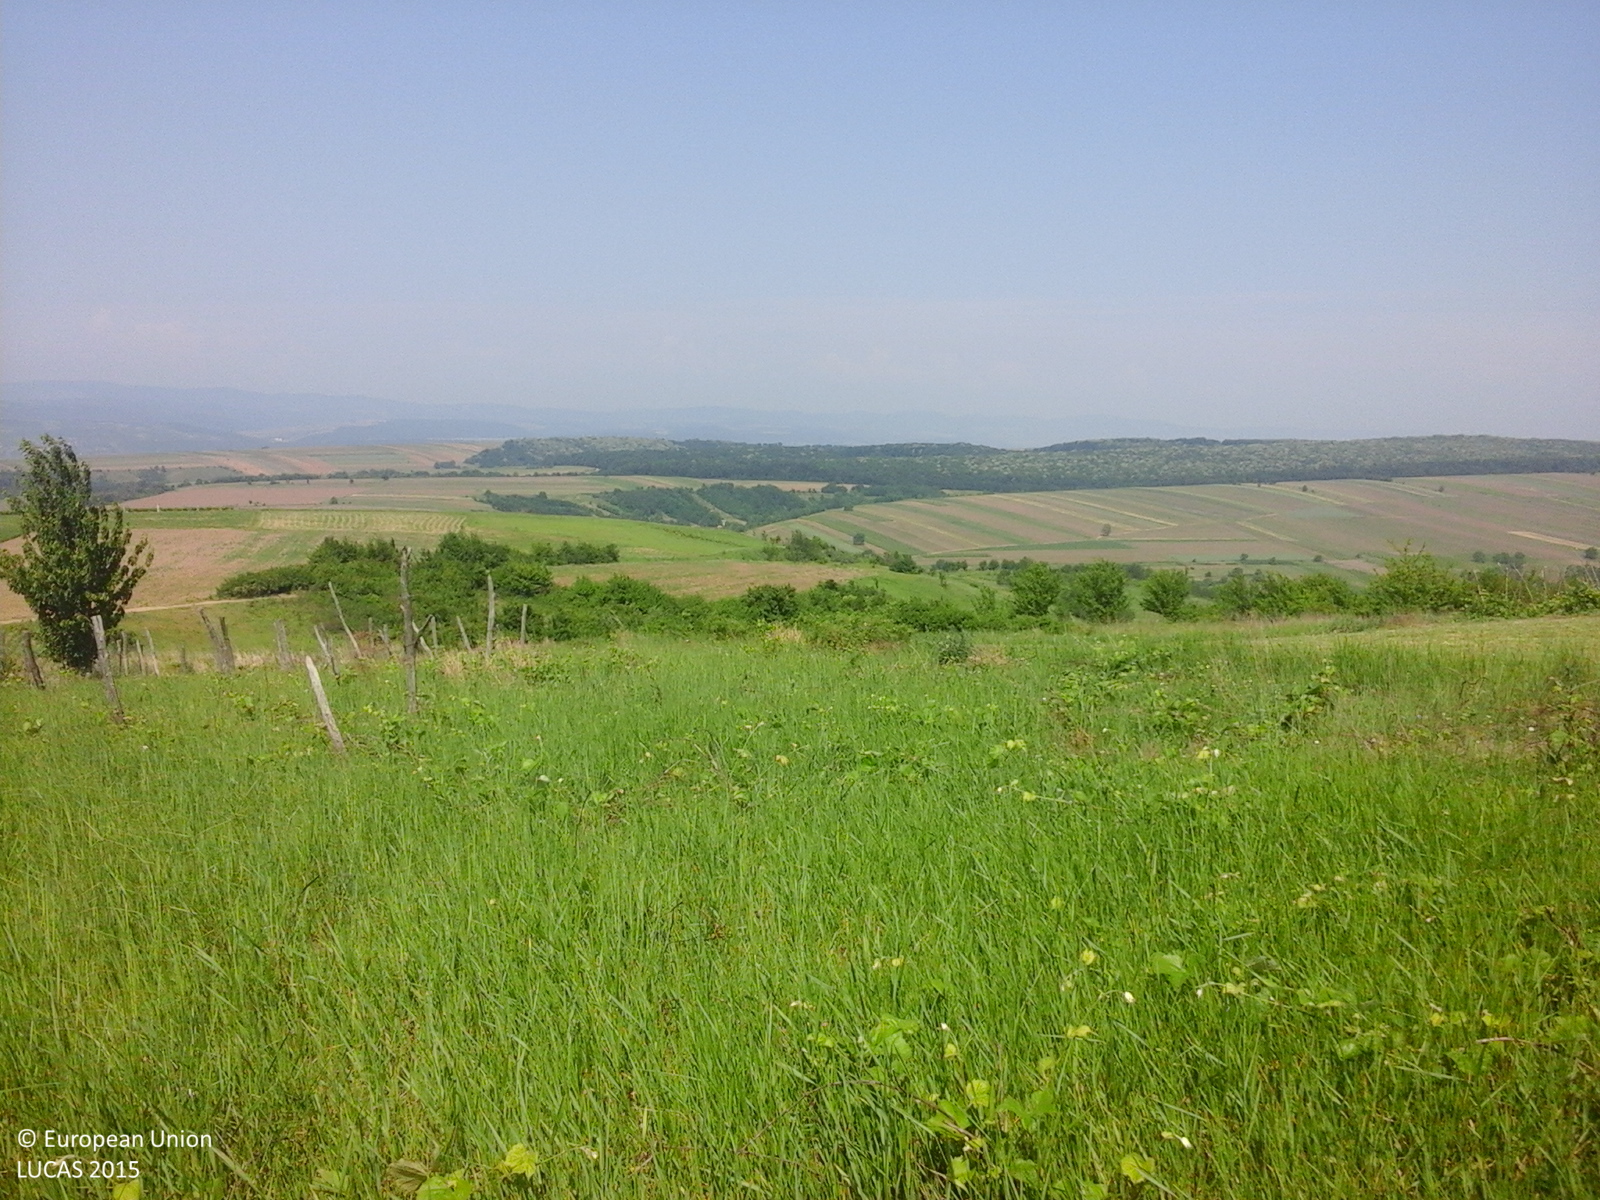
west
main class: Cropland
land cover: Vineyards
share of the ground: 10 - 25 %
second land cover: Grassland without tree/shrub cover
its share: 50 - 75 %
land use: Agriculture (excluding fallow land and kitchen gardens)
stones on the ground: < 10 %
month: June
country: RO
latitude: 46.3399
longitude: 27.1045
